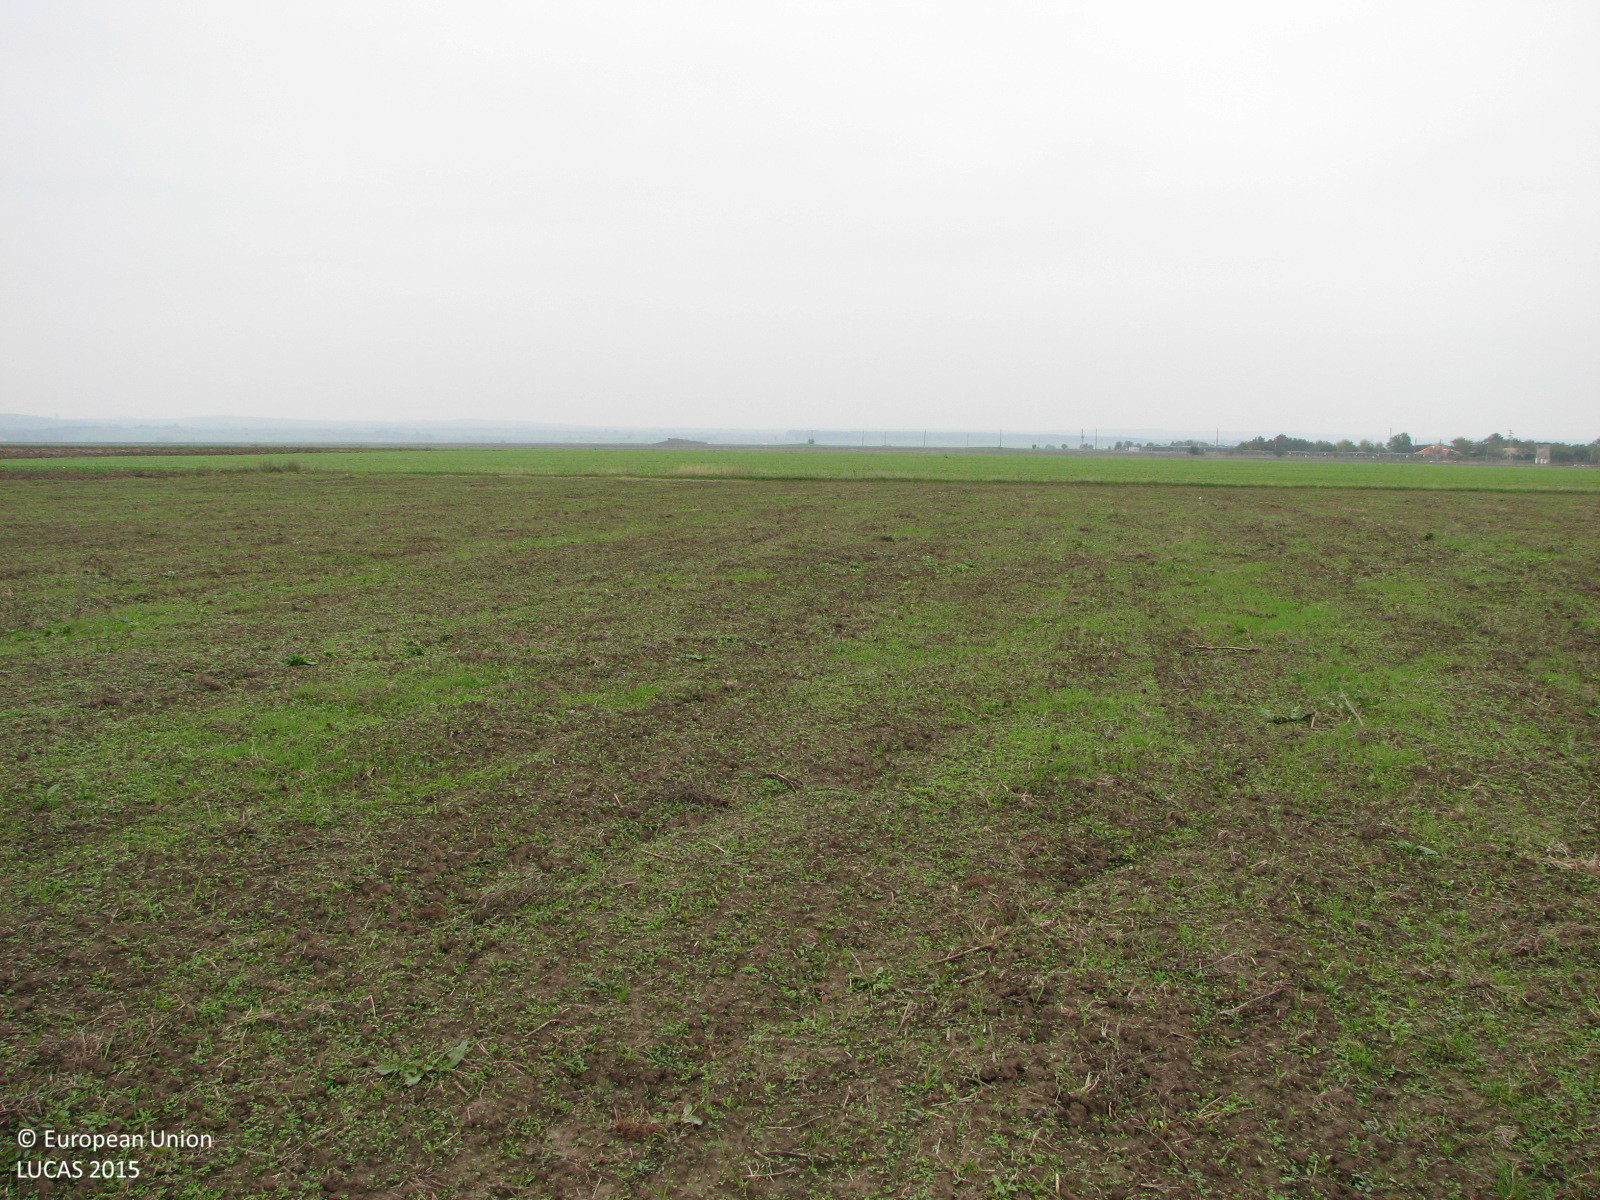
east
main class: Grassland
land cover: Spontaneously vegetated surfaces
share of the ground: 25 - 50 %
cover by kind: herbaceous plants 100 %
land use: Agriculture (excluding fallow land and kitchen gardens)
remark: Harvested field
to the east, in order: Spontaneously vegetated surfaces; Common wheat; Tracks; Common wheat; Other bare soil; Spontaneously vegetated surfaces
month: October
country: BG
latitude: 42.5680
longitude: 26.7767
